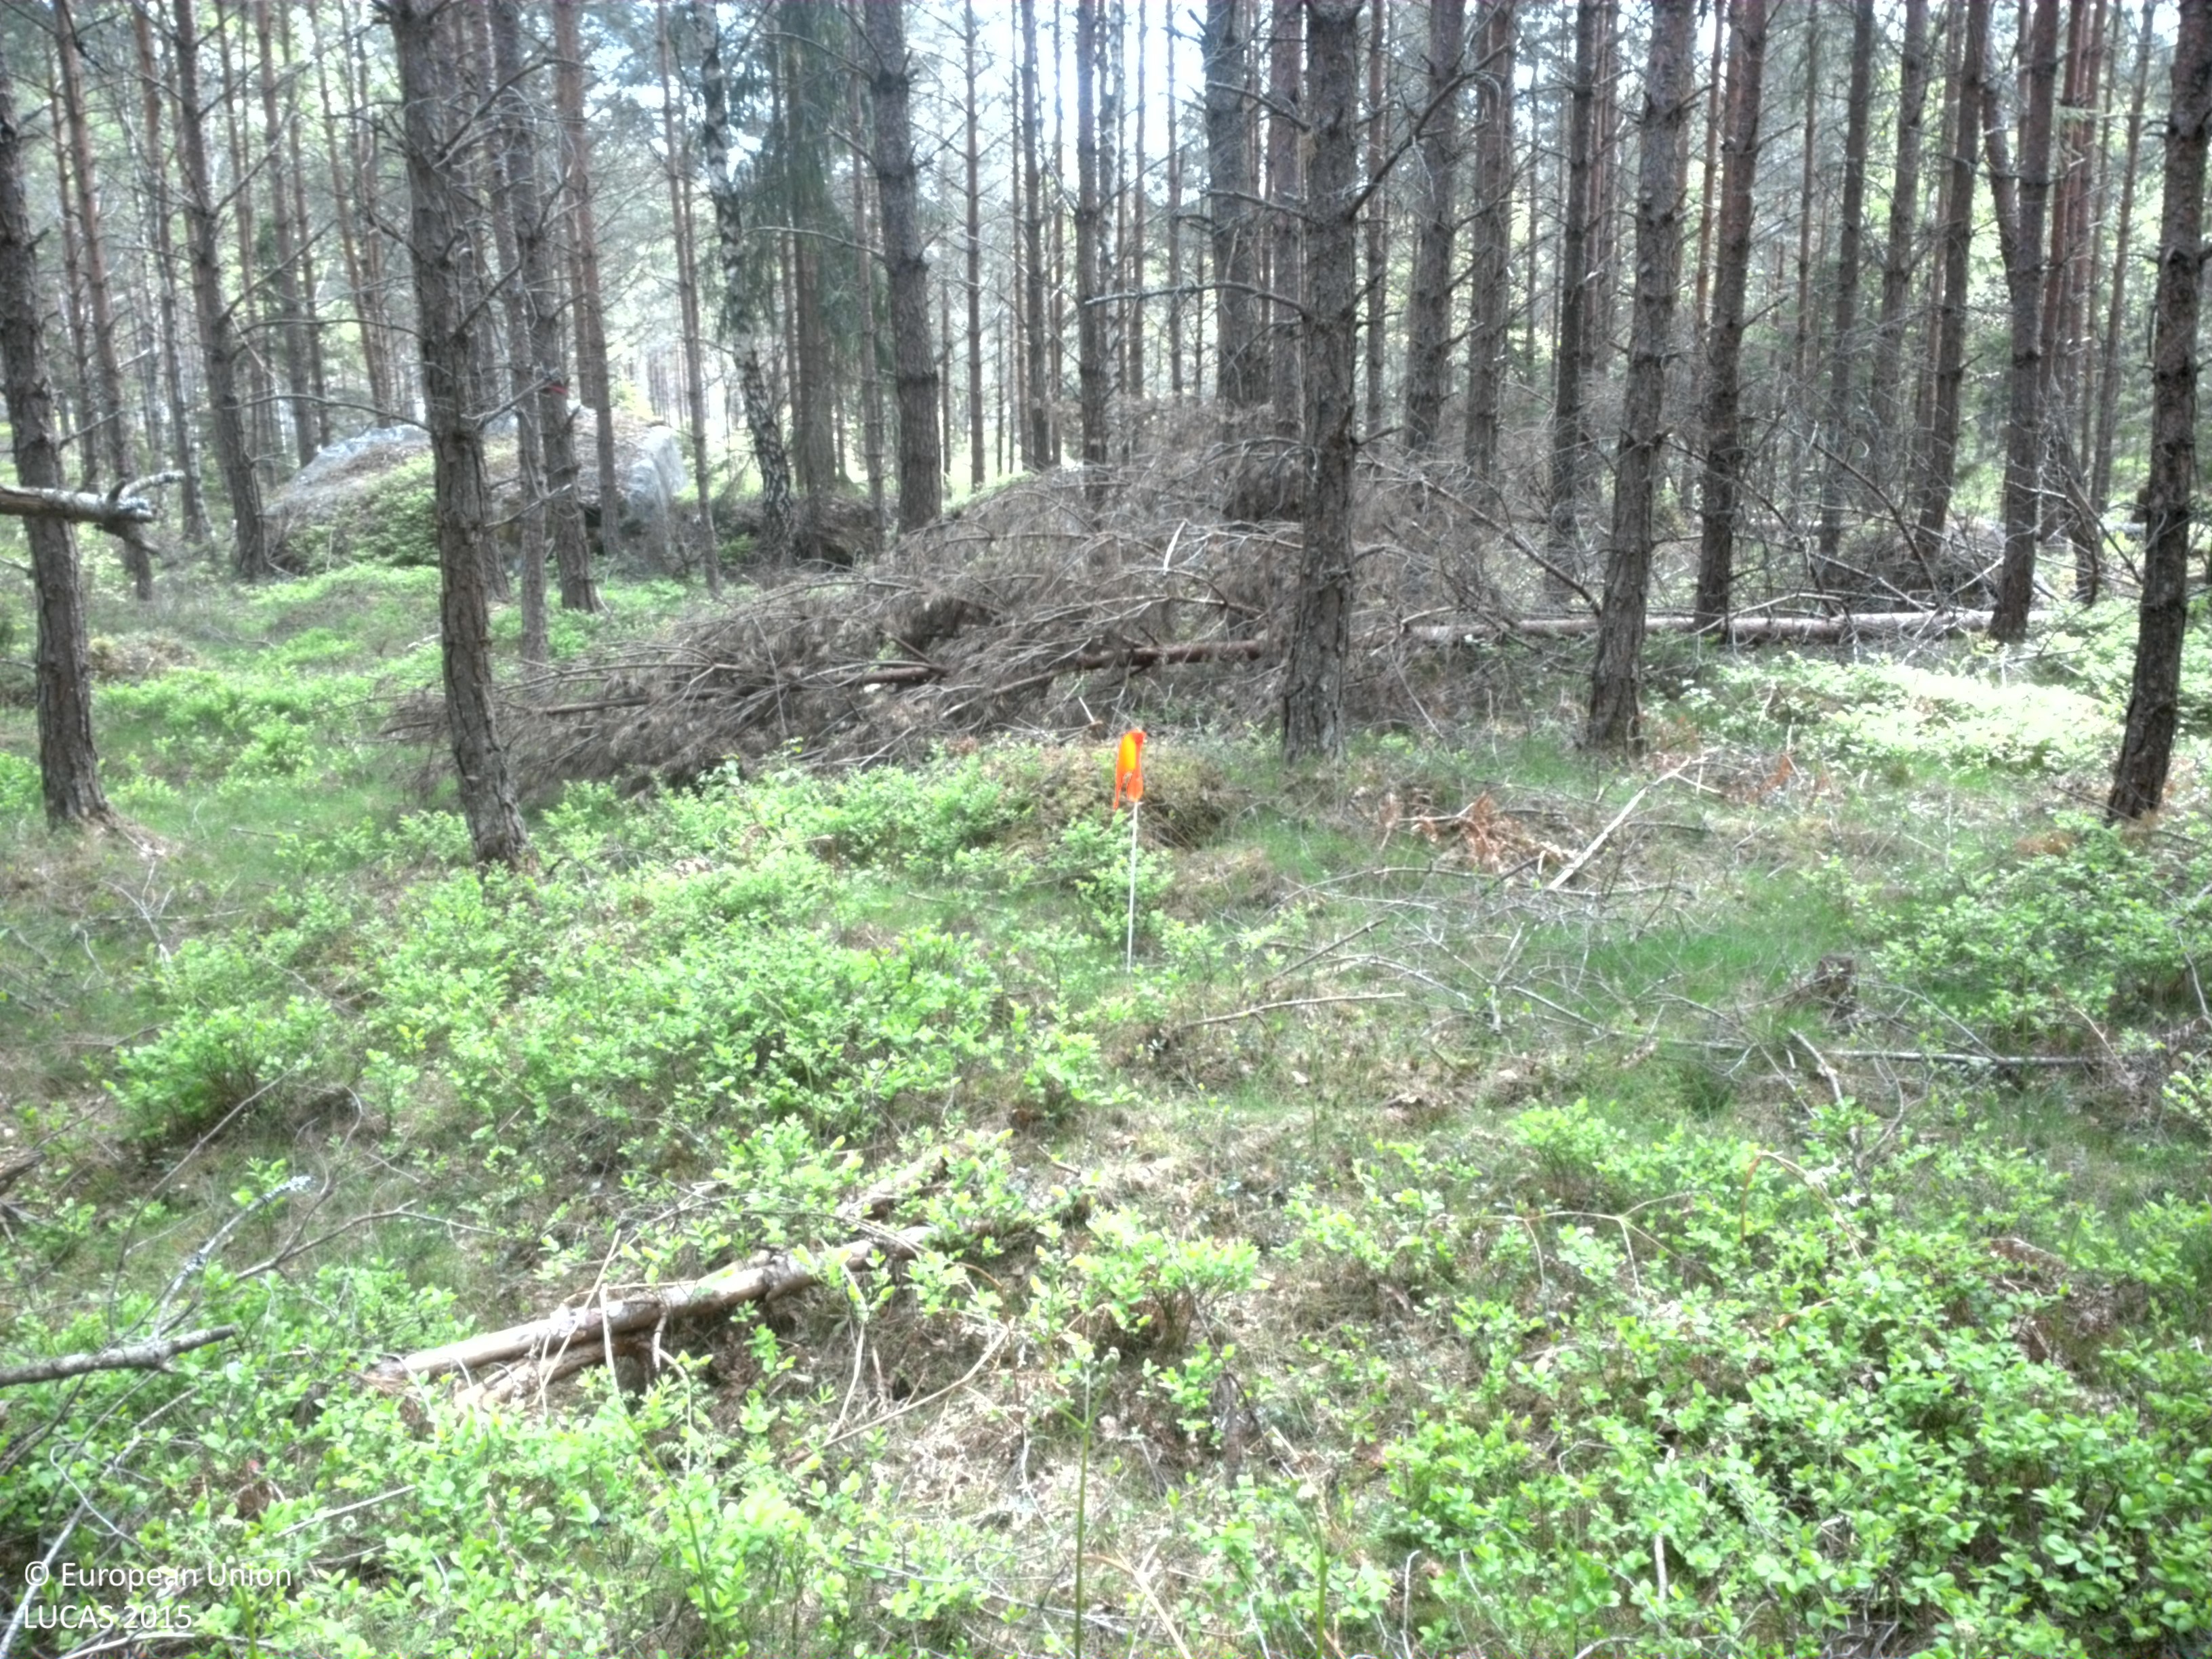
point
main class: Woodland
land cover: Pine dominated coniferous woodland
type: boreal forest
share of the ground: > 75 %
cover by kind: coniferous forest trees 85 %, shrubs 15 %
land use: Forestry
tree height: > 5 m
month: May
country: SE
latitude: 56.5514
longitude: 15.1876
